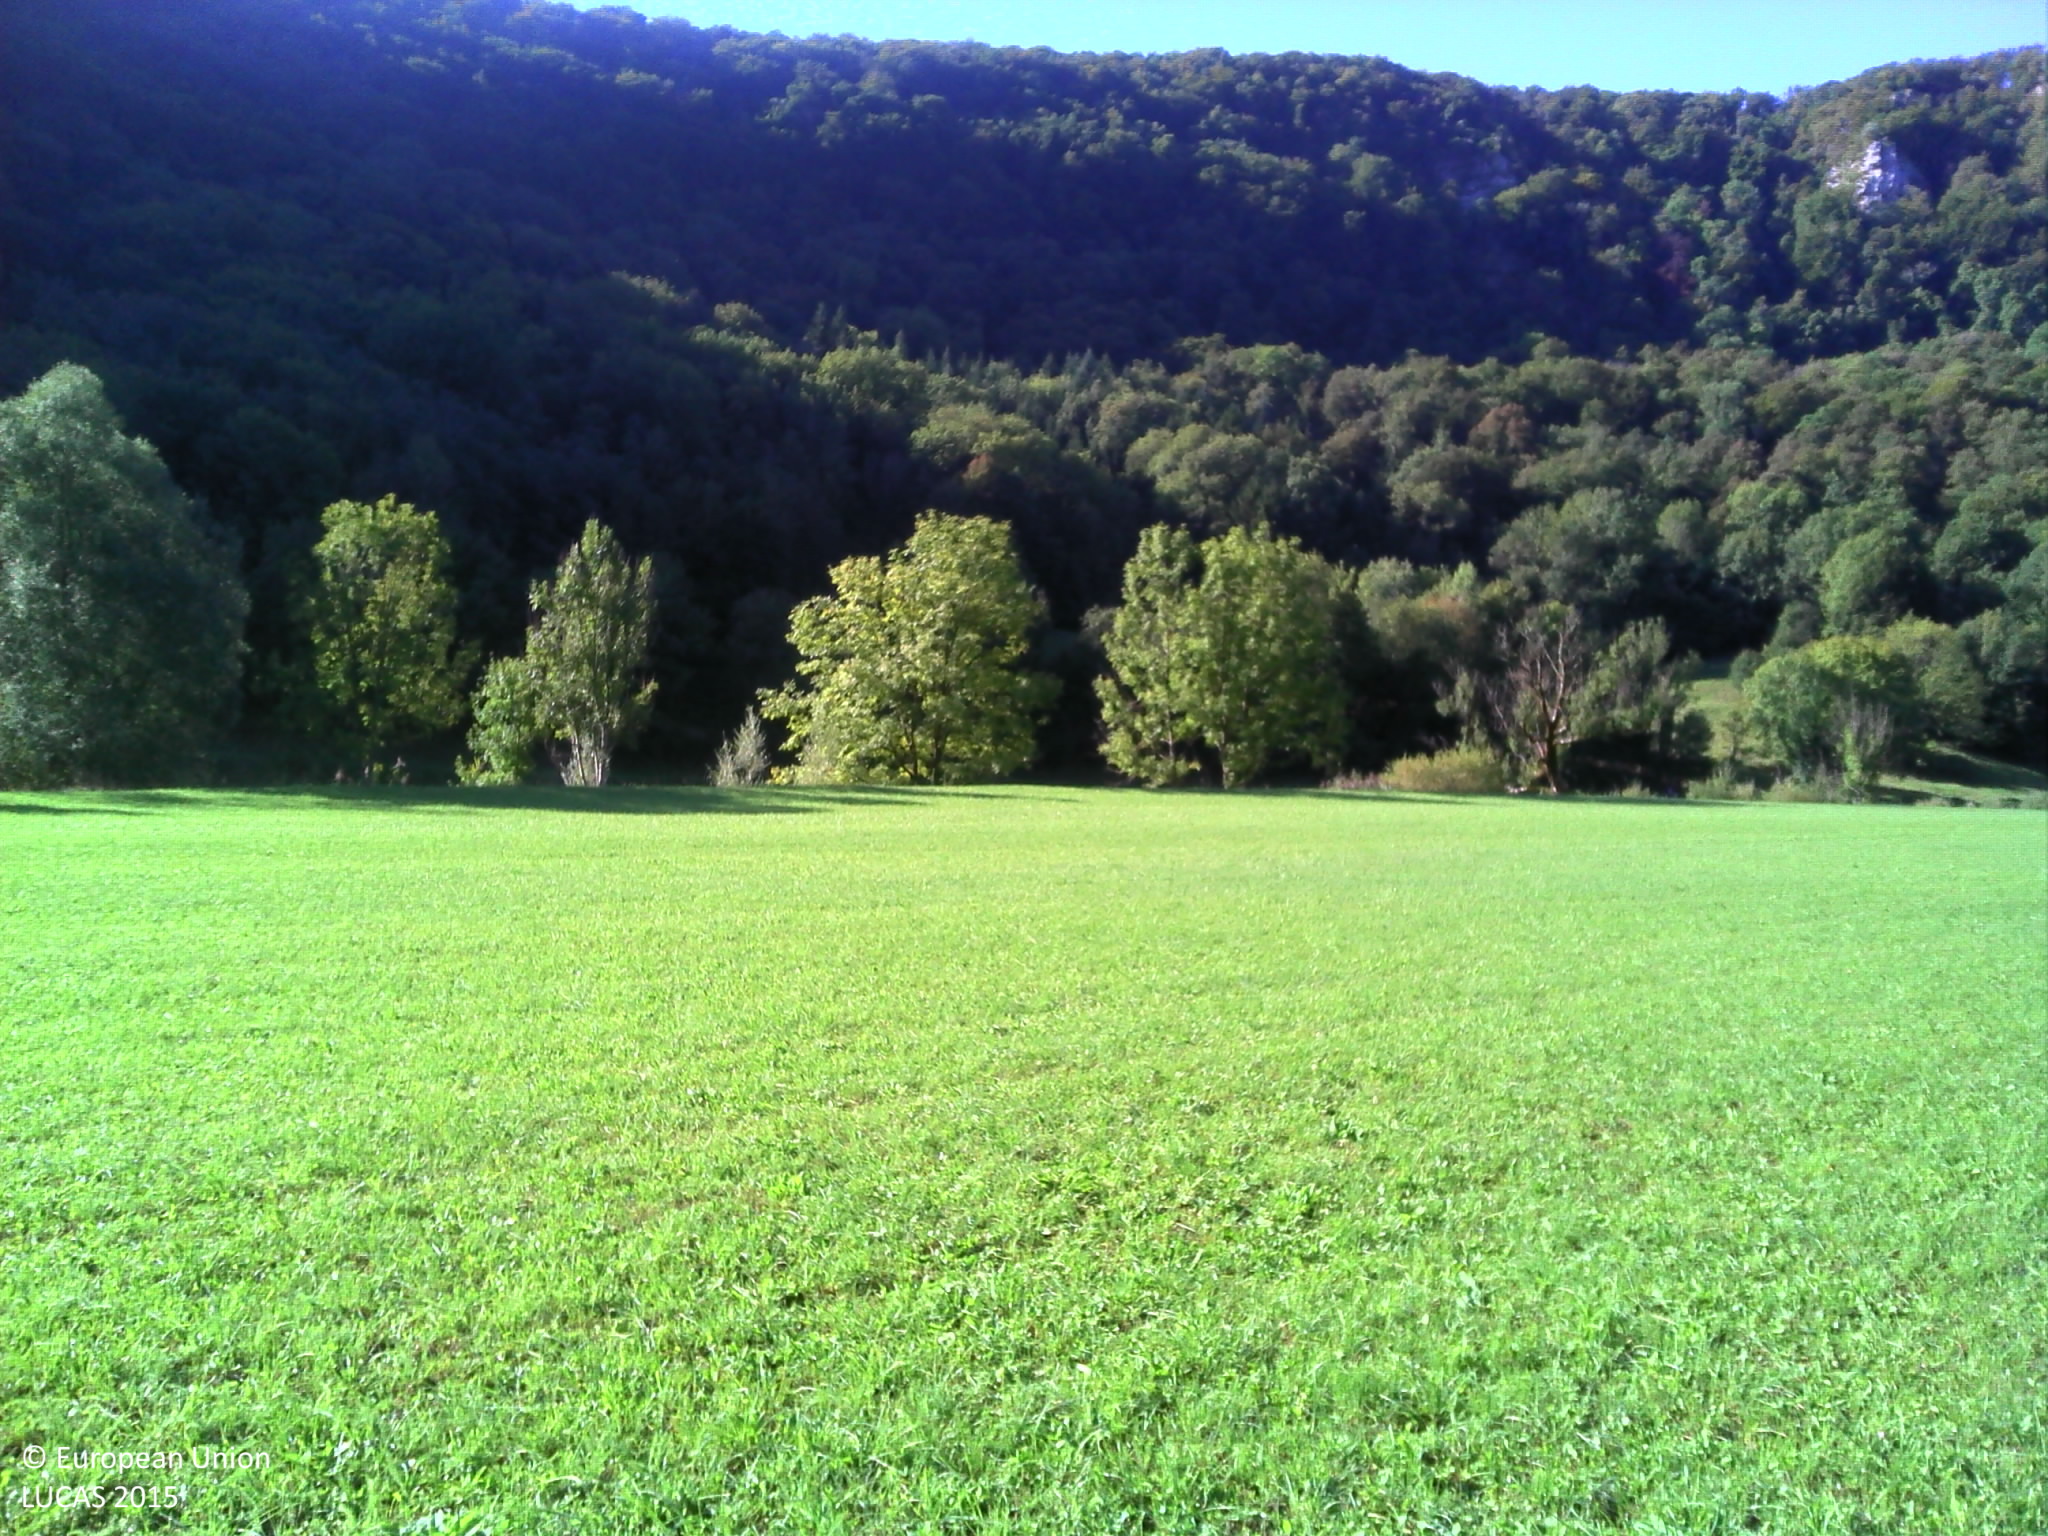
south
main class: Grassland
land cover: Grassland without tree/shrub cover
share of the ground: > 75 %
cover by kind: herbaceous plants 100 %
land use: Agriculture (excluding fallow land and kitchen gardens)
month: September
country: FR
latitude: 47.3537
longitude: 6.3876
